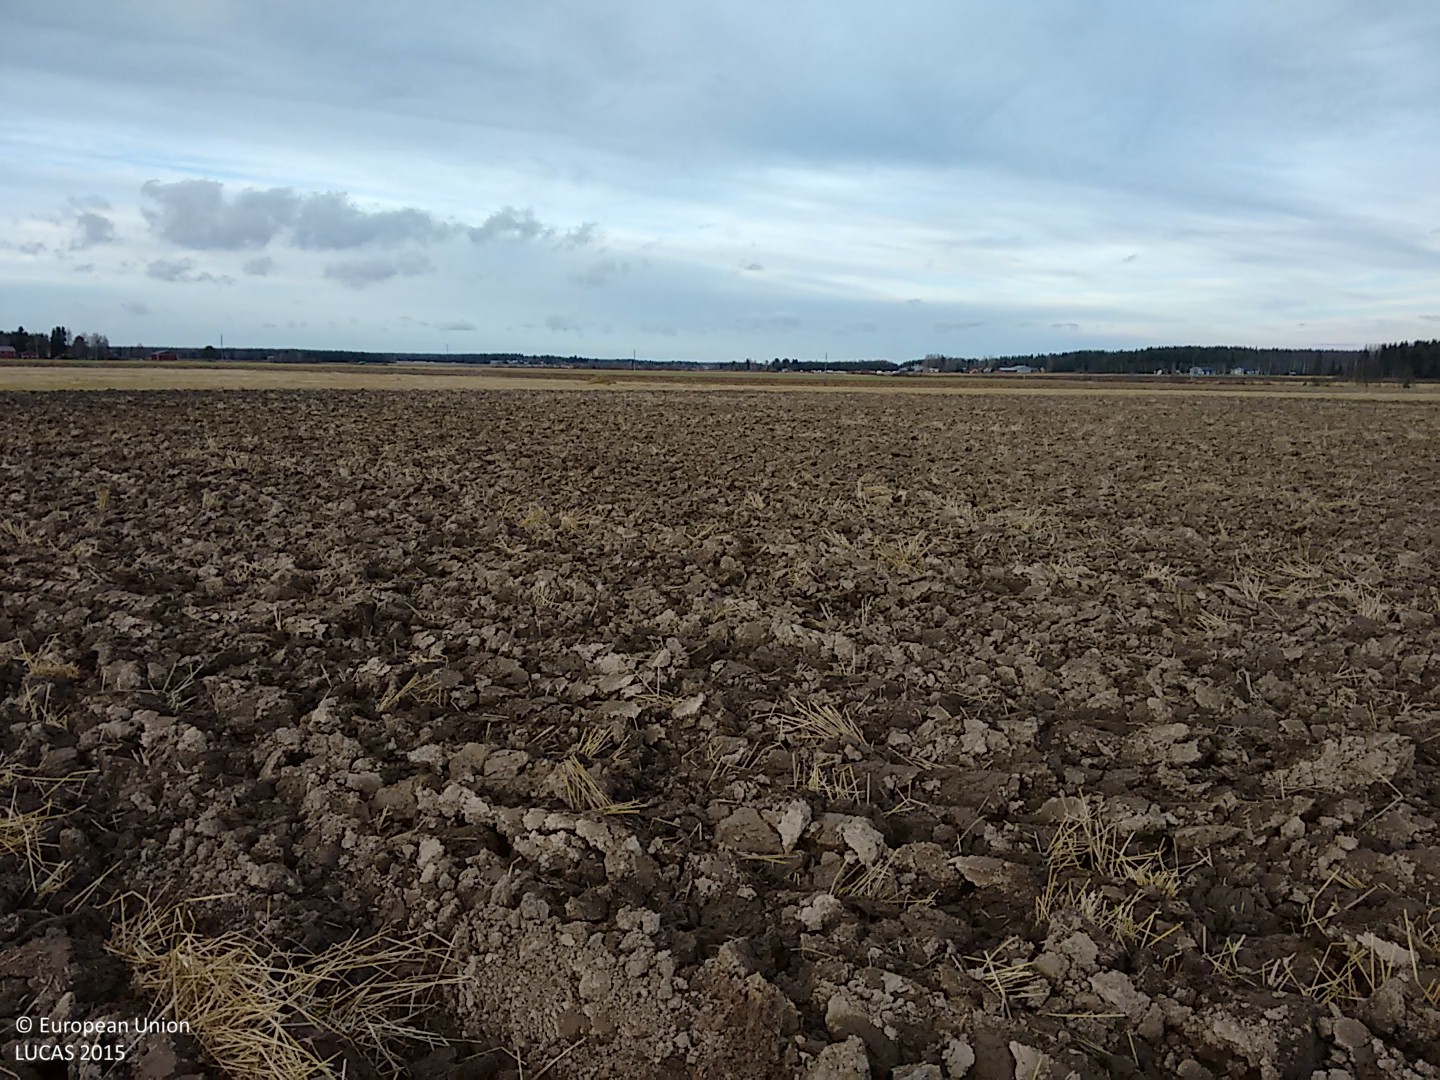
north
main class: Cropland
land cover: Barley
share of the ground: < 10 %
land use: Agriculture (excluding fallow land and kitchen gardens)
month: October
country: FI
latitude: 63.9341
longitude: 25.0379
